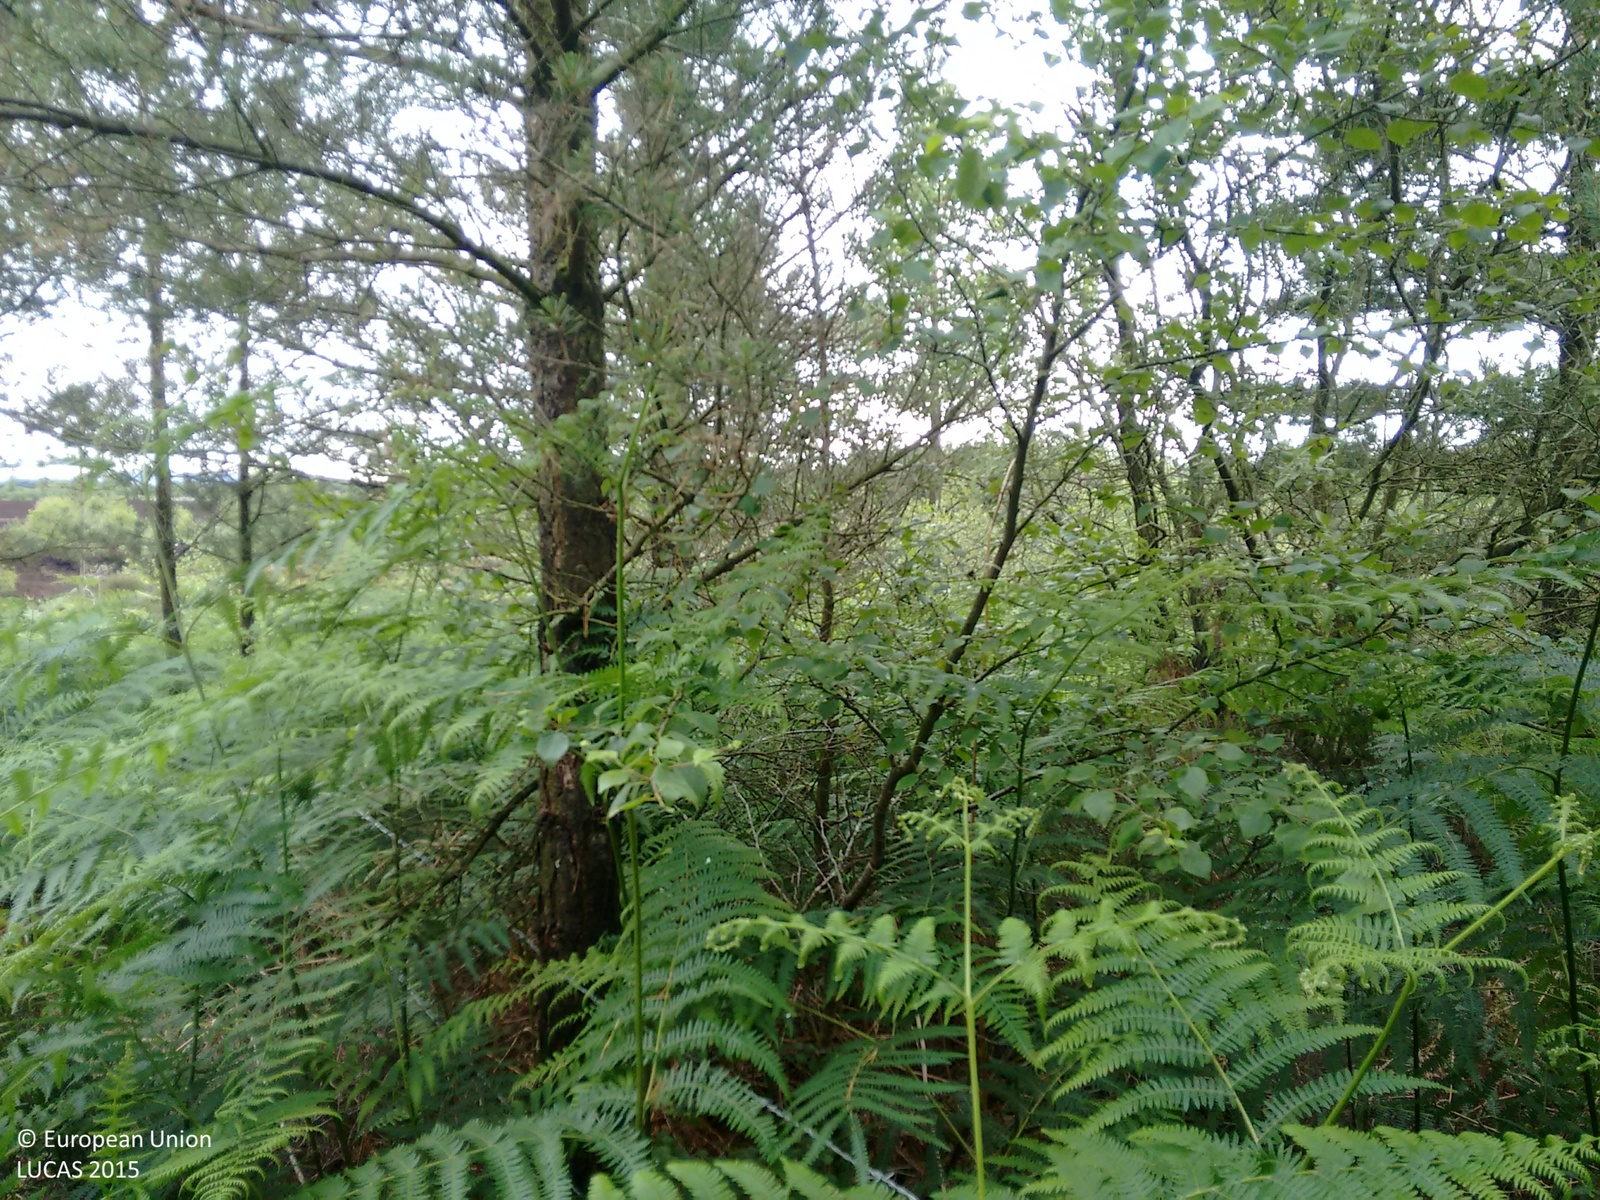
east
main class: Woodland
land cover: Pine dominated mixed woodland
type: hemiboreal forest and nemoral coniferous forest and mixed broadleaved-coniferous forest
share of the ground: 50 - 75 %
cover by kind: coniferous forest trees 60 %, broadleaved forest trees 20 %, shrubs 20 %
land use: Semi-natural and natural areas not in use
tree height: < 5 m
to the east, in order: Pine dominated mixed woodland; Fences; Shrubland with sparse tree cover; Peatbogs; Shrubland with sparse tree cover; Grassland without tree/shrub cover; Shrubland with sparse tree cover; Spontaneously vegetated surfaces; Ditches and canals; Pine dominated mixed woodland; Grassland without tree/shrub cover; Abandoned hedges; Broadleaved woodland; Peatbogs; Ditches and canals; Peatbogs; Ditches and canals; Peatbogs; Ditches and canals; Peatbogs; Ditches and canals; Peatbogs
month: July
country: IE
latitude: 52.6781
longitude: -7.6617
